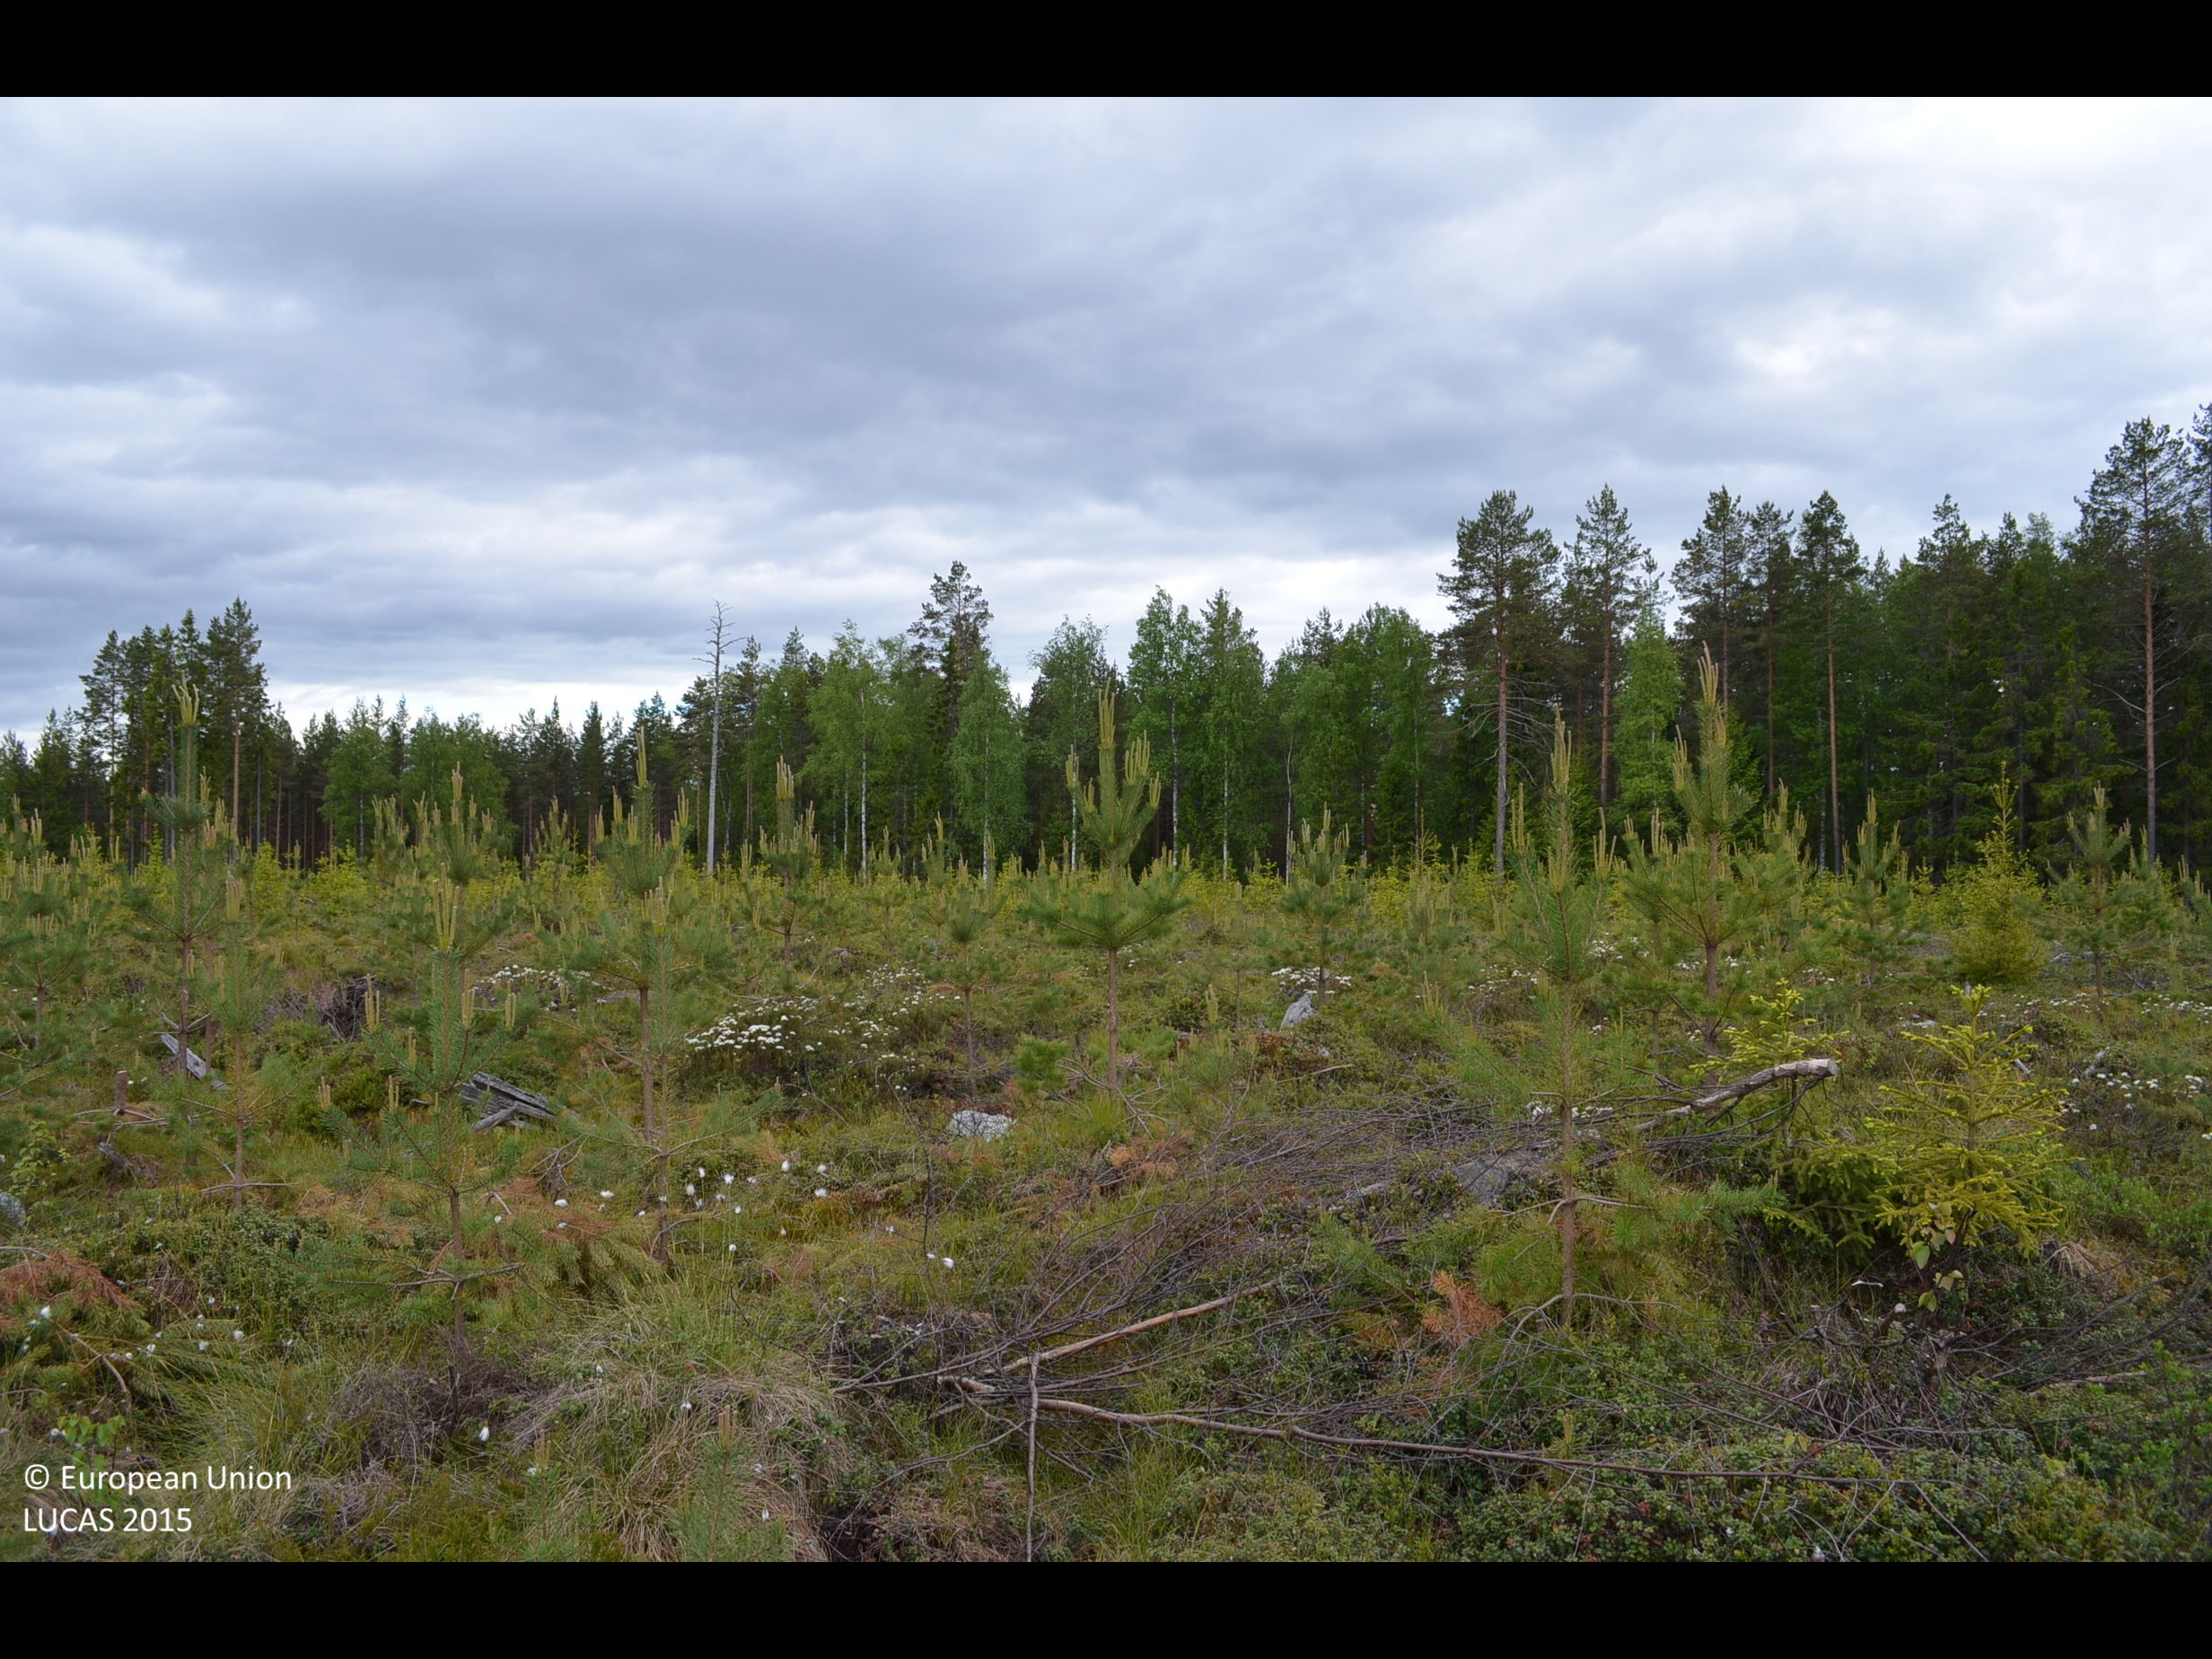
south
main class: Woodland
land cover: Other coniferous woodland
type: boreal forest
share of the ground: 25 - 50 %
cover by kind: shrubs 45 %, coniferous forest trees 35 %, lichens and mosses 10 %, herbaceous plants 5 %
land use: Forestry
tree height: < 5 m
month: June
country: FI
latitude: 61.9019
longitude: 23.3779
